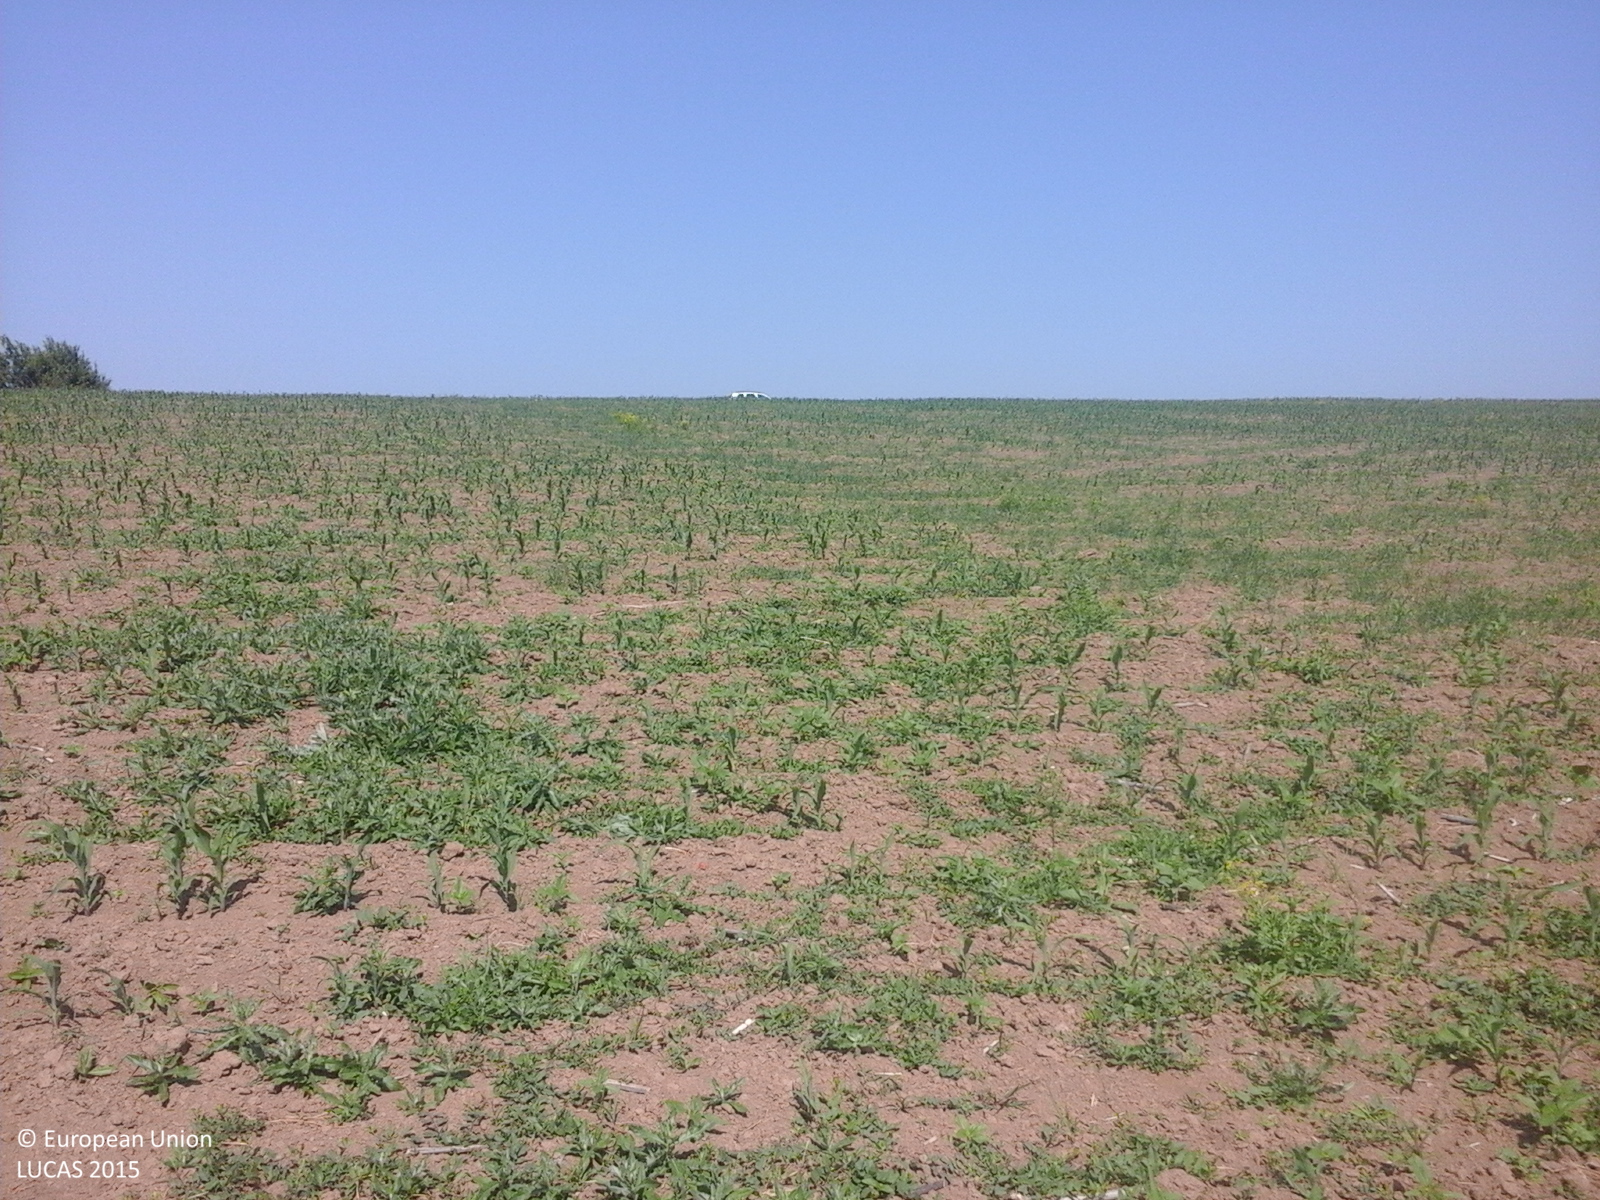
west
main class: Cropland
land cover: Maize
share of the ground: 10 - 25 %
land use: Agriculture (excluding fallow land and kitchen gardens)
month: June
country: RO
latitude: 46.5793
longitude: 27.1026
